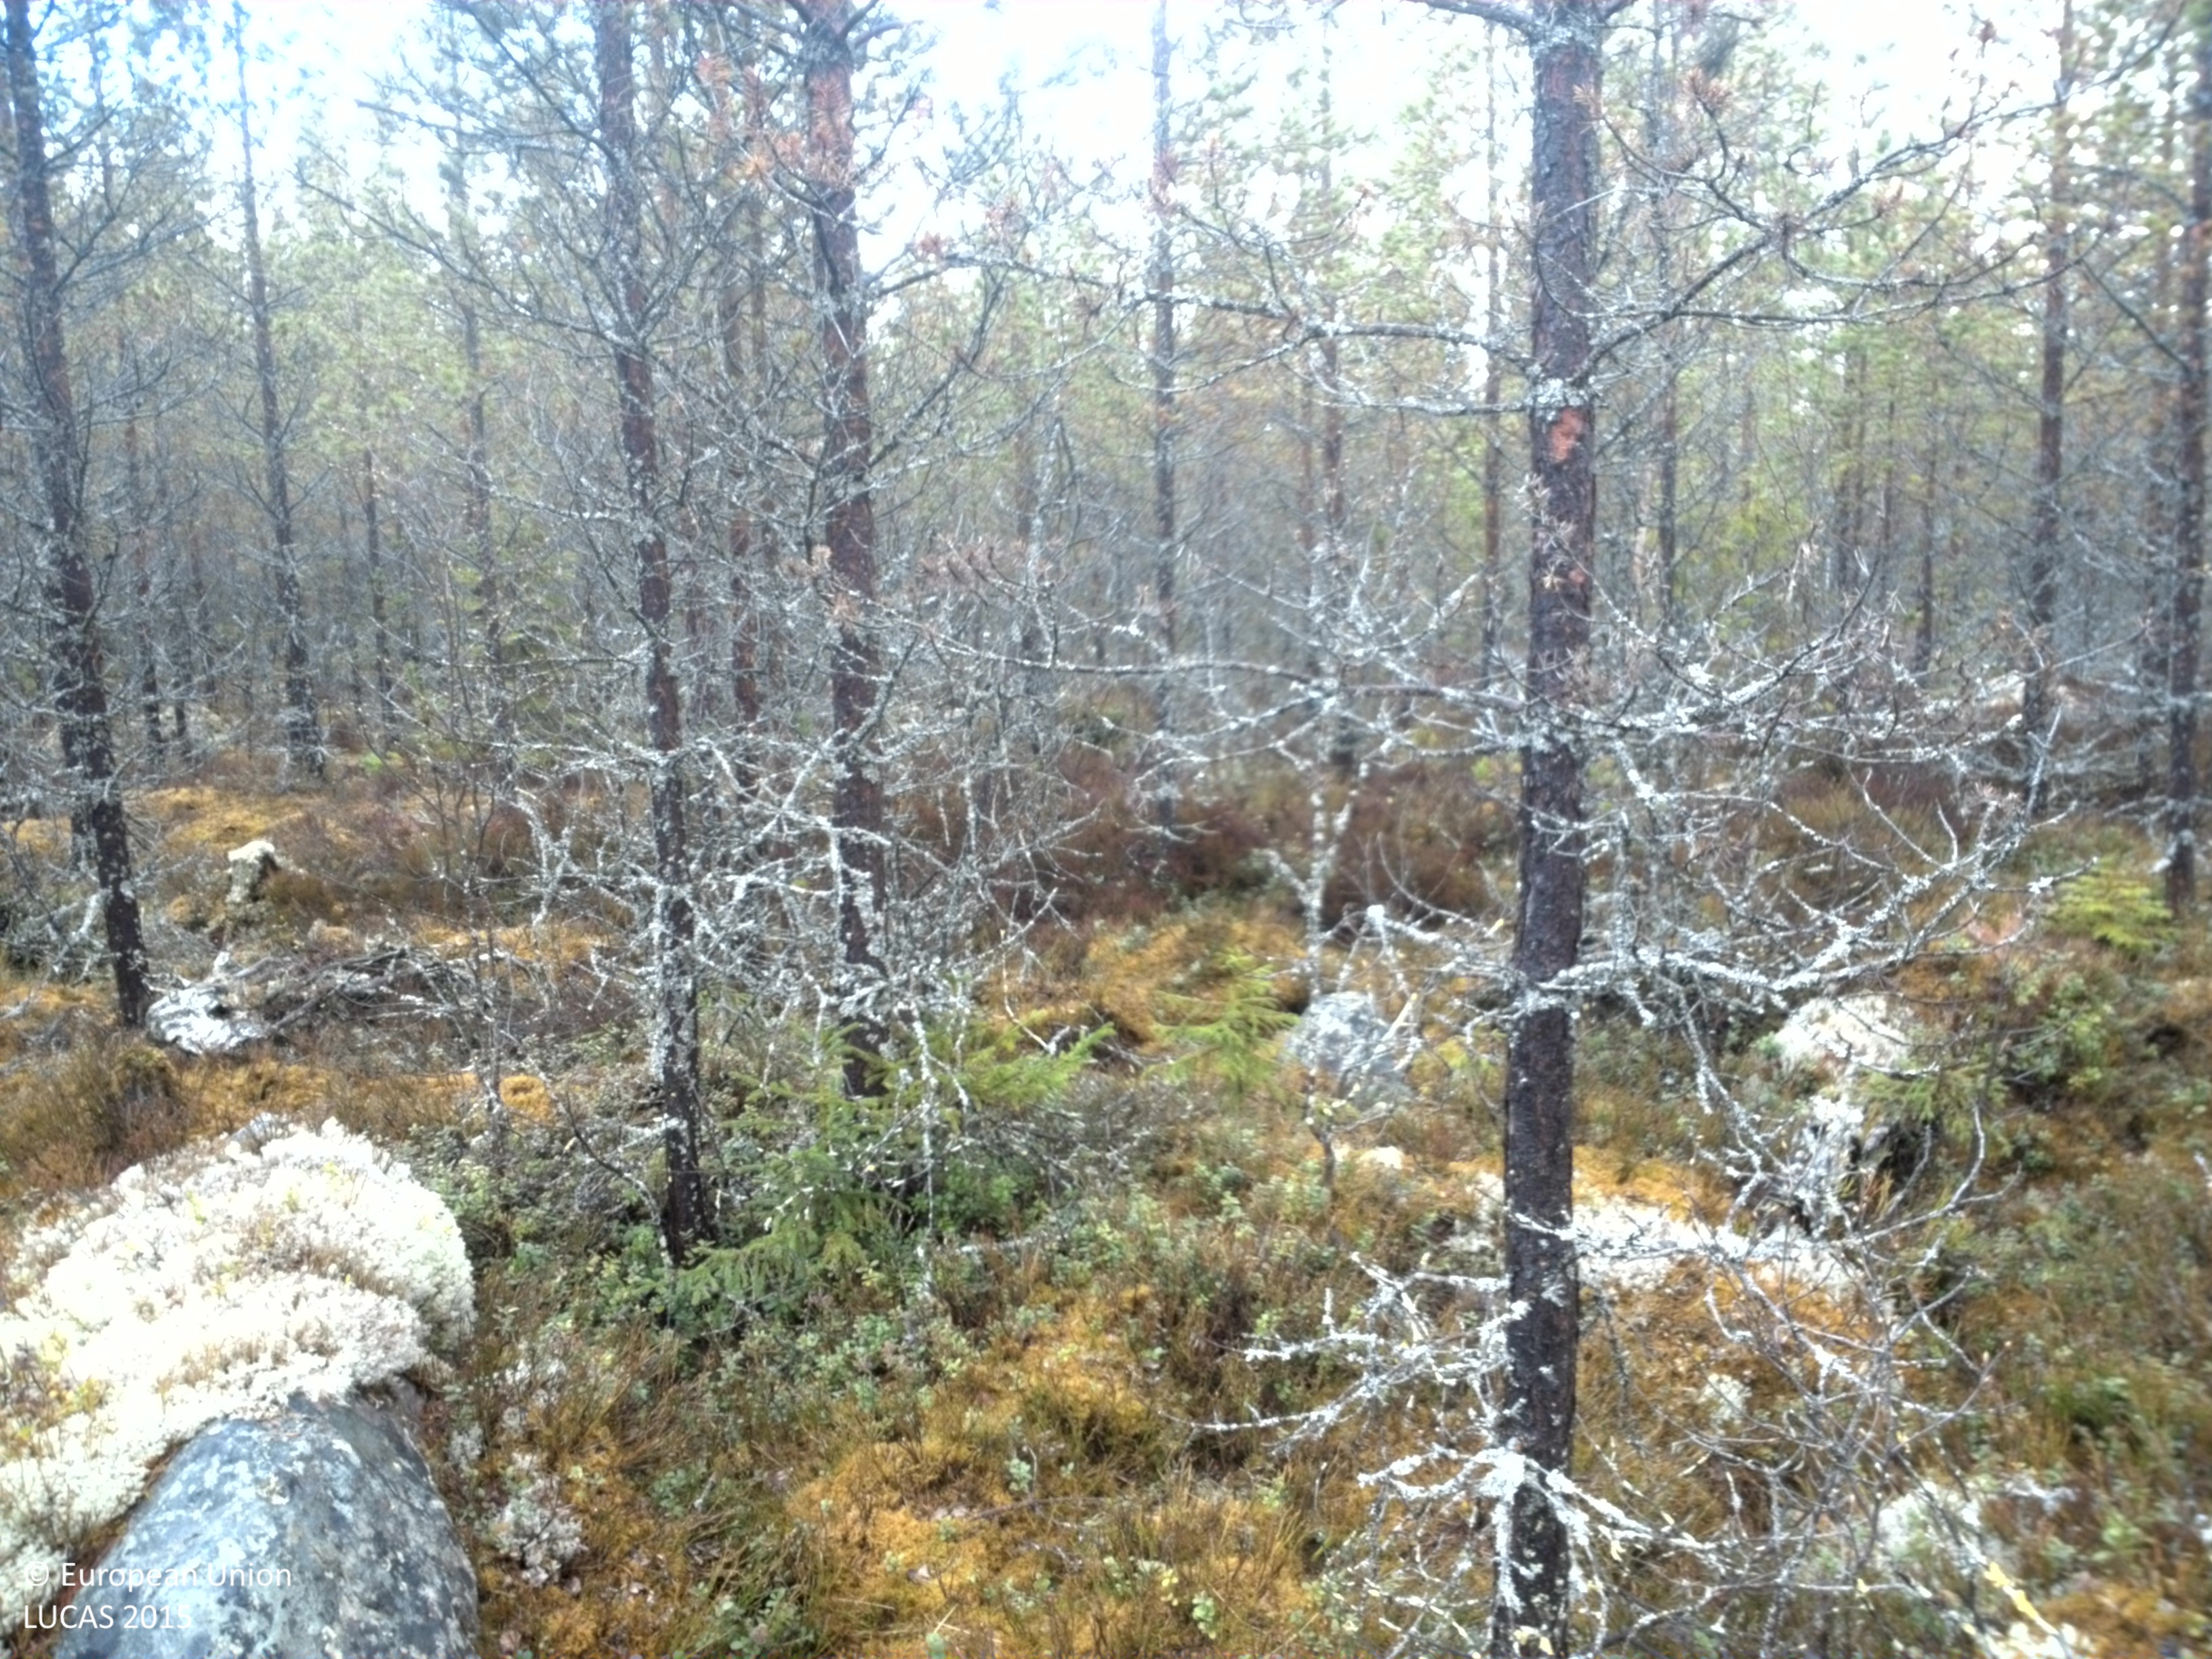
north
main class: Woodland
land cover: Pine dominated coniferous woodland
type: boreal forest
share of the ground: 50 - 75 %
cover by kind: coniferous forest trees 75 %, shrubs 25 %
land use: Forestry
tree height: < 5 m
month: May
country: SE
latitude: 60.9659
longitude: 13.5166
